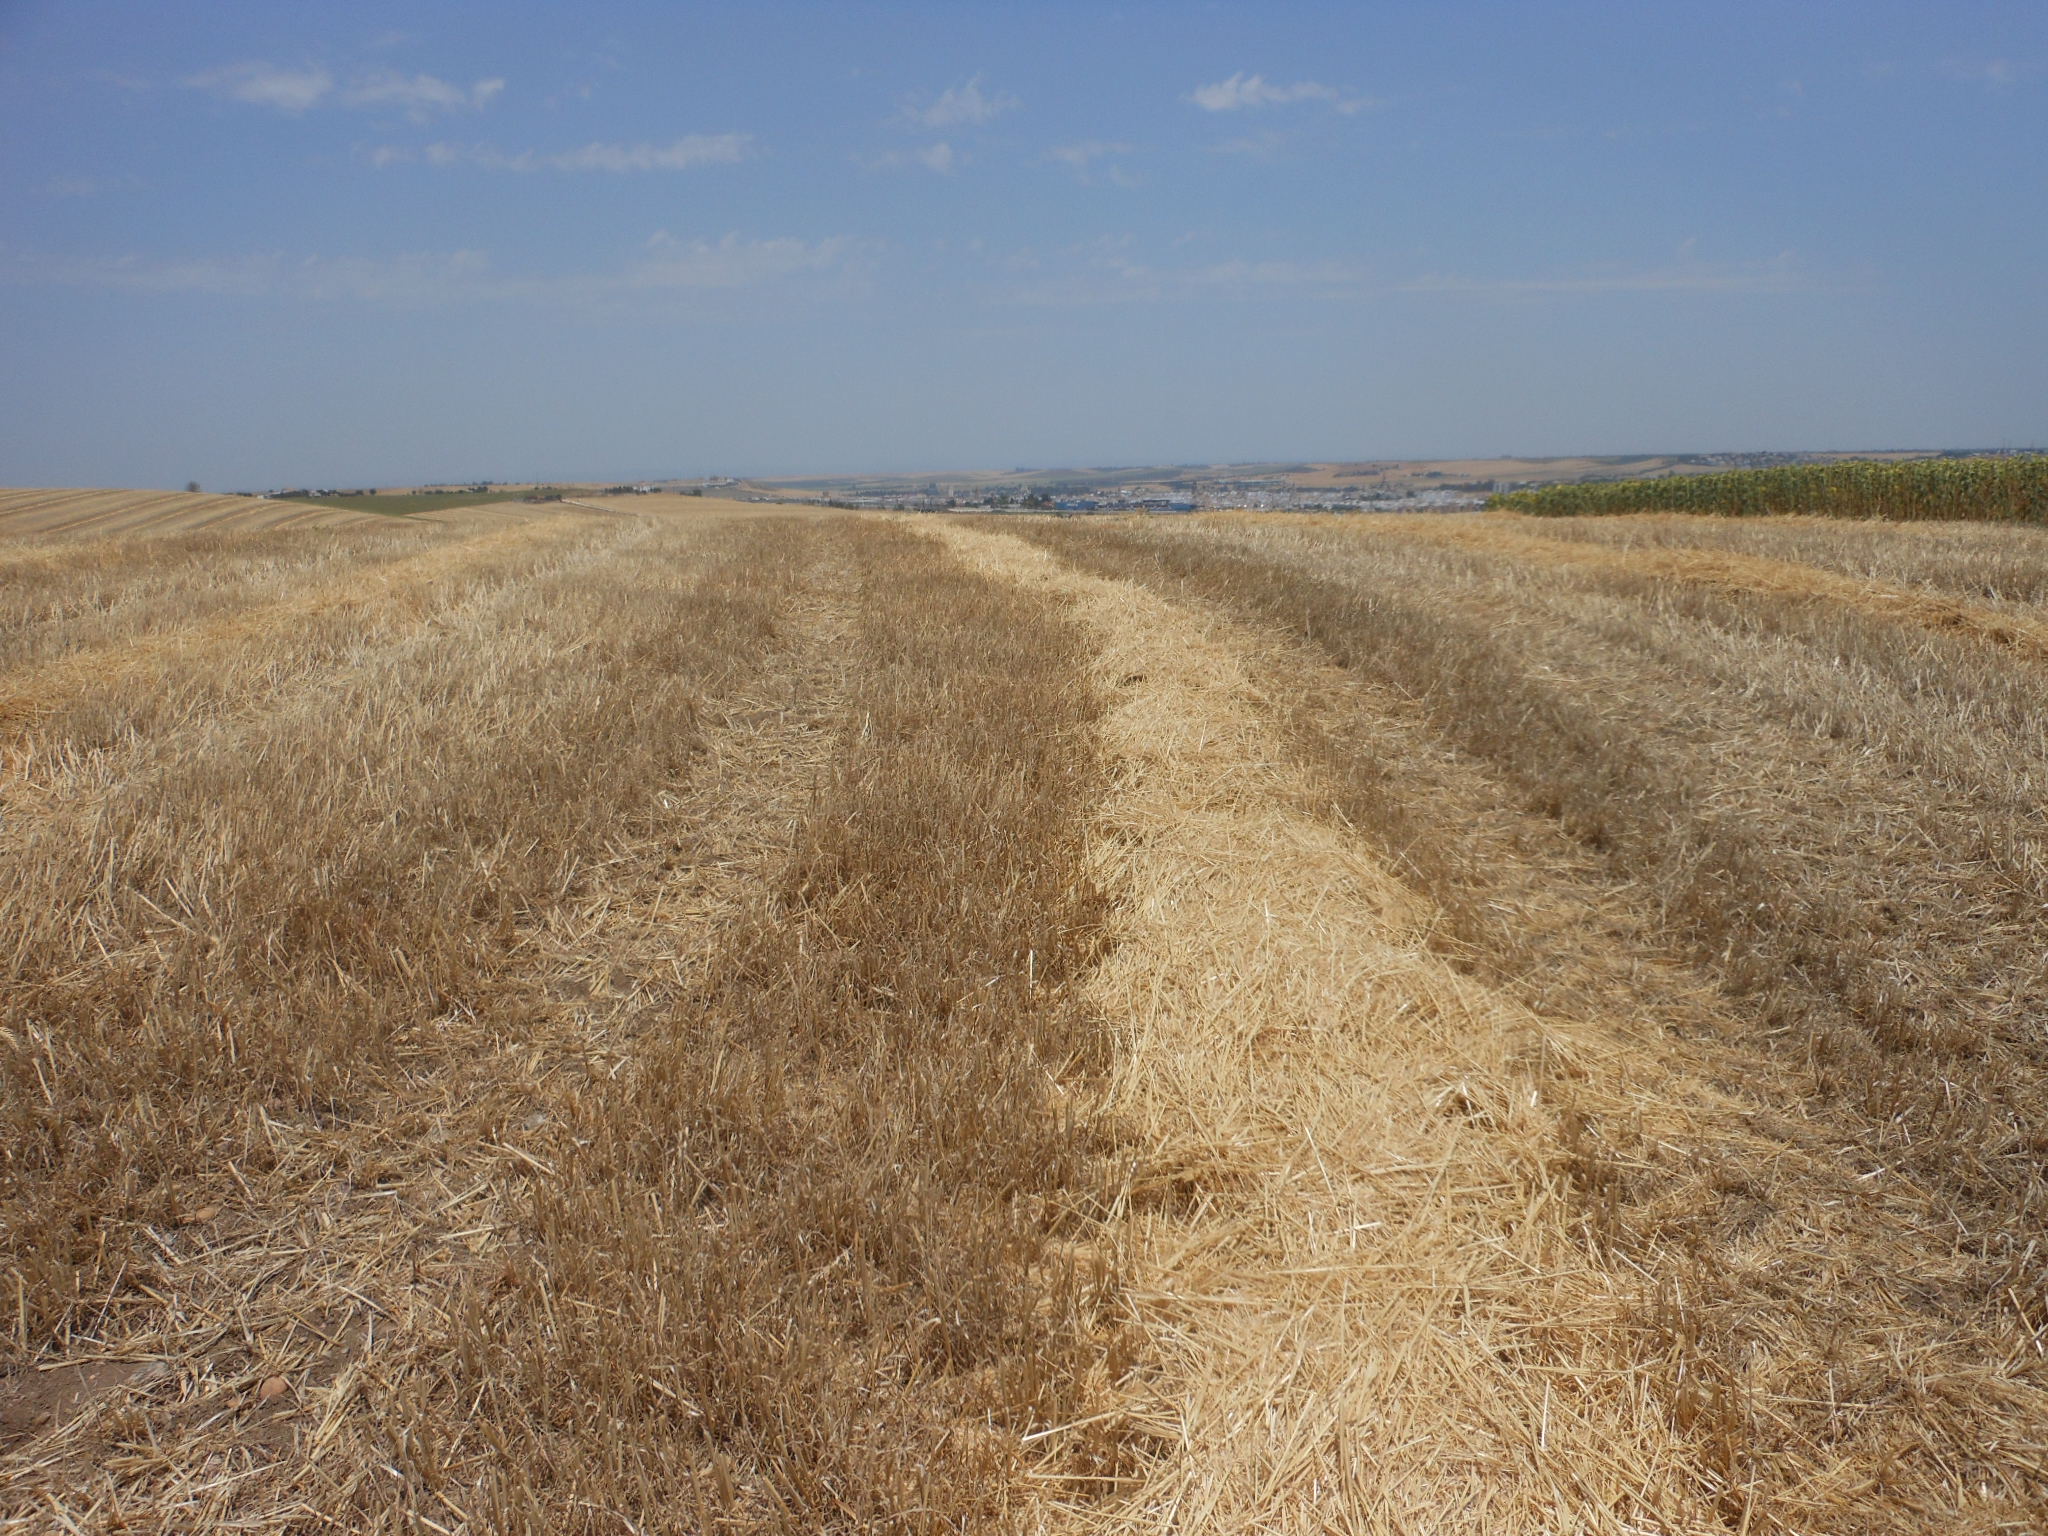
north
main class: Cropland
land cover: Durum wheat
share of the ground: < 10 %
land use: Agriculture (excluding fallow land and kitchen gardens)
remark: Harvested field
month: June
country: ES
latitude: 37.5110
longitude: -5.0927
